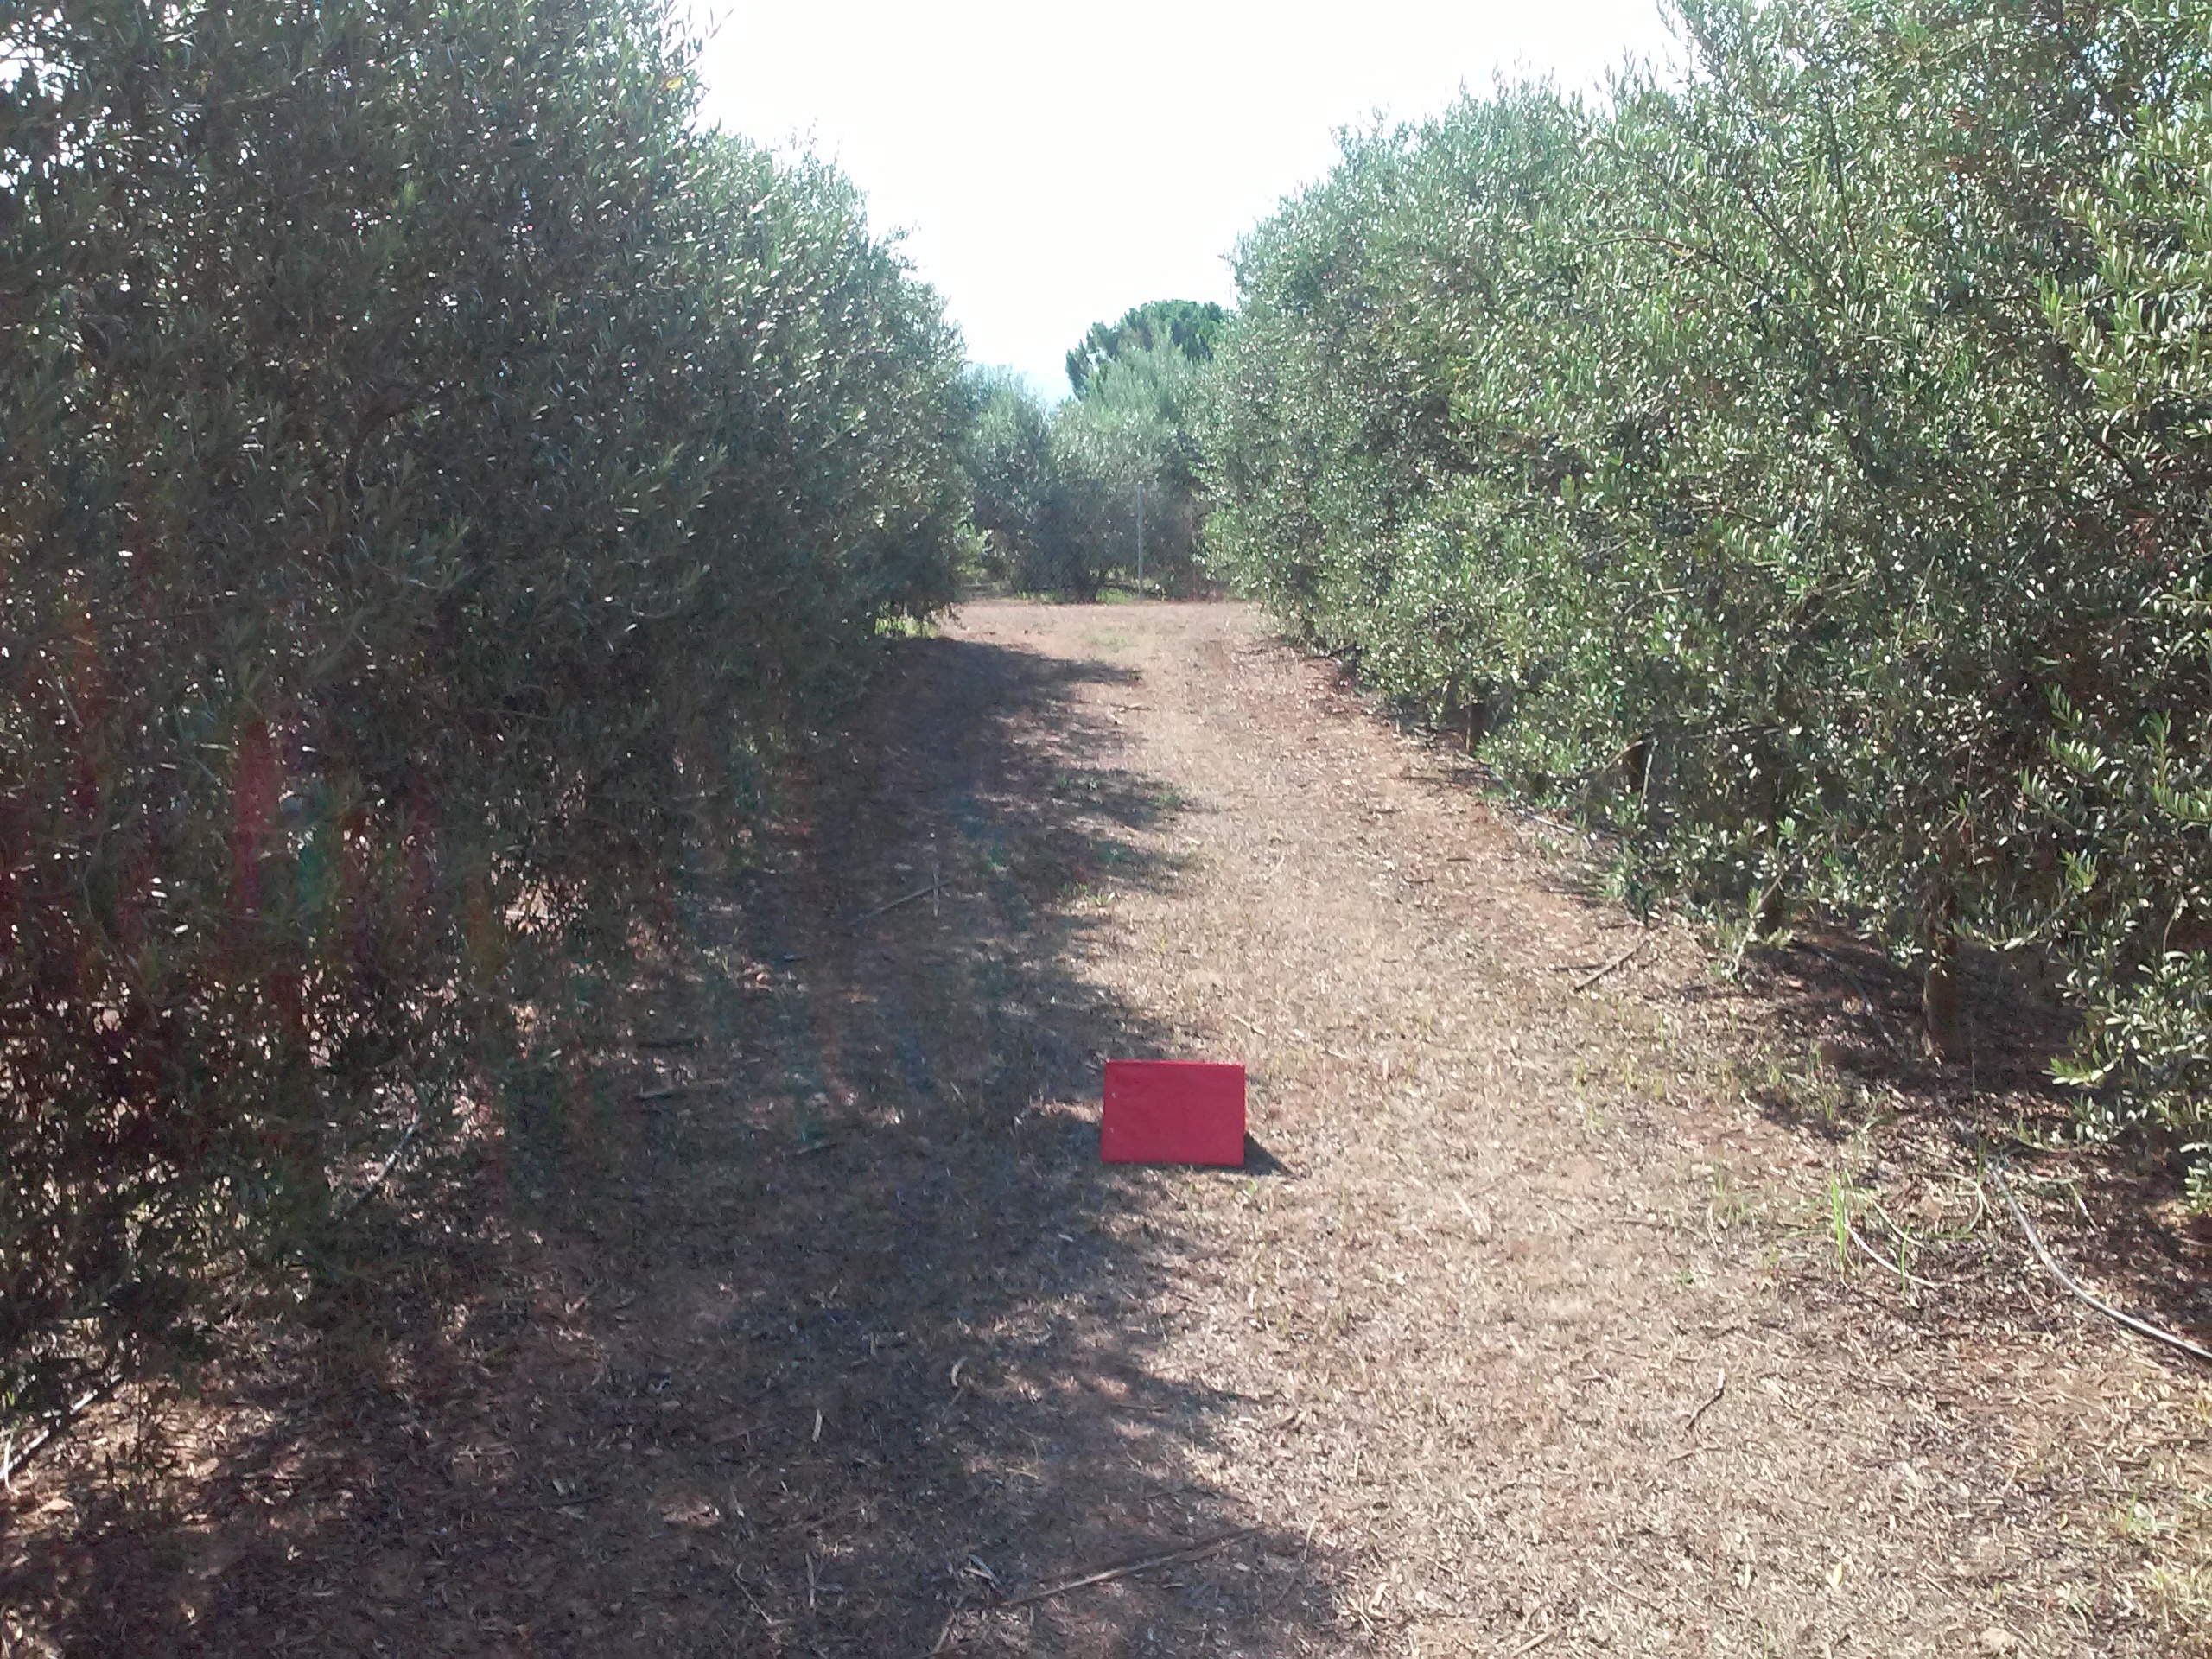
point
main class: Cropland
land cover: Olive groves
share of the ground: 10 - 25 %
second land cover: Other bare soil
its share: > 75 %
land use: Agriculture (excluding fallow land and kitchen gardens)
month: August
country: ES
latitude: 41.0911
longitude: 0.6228
